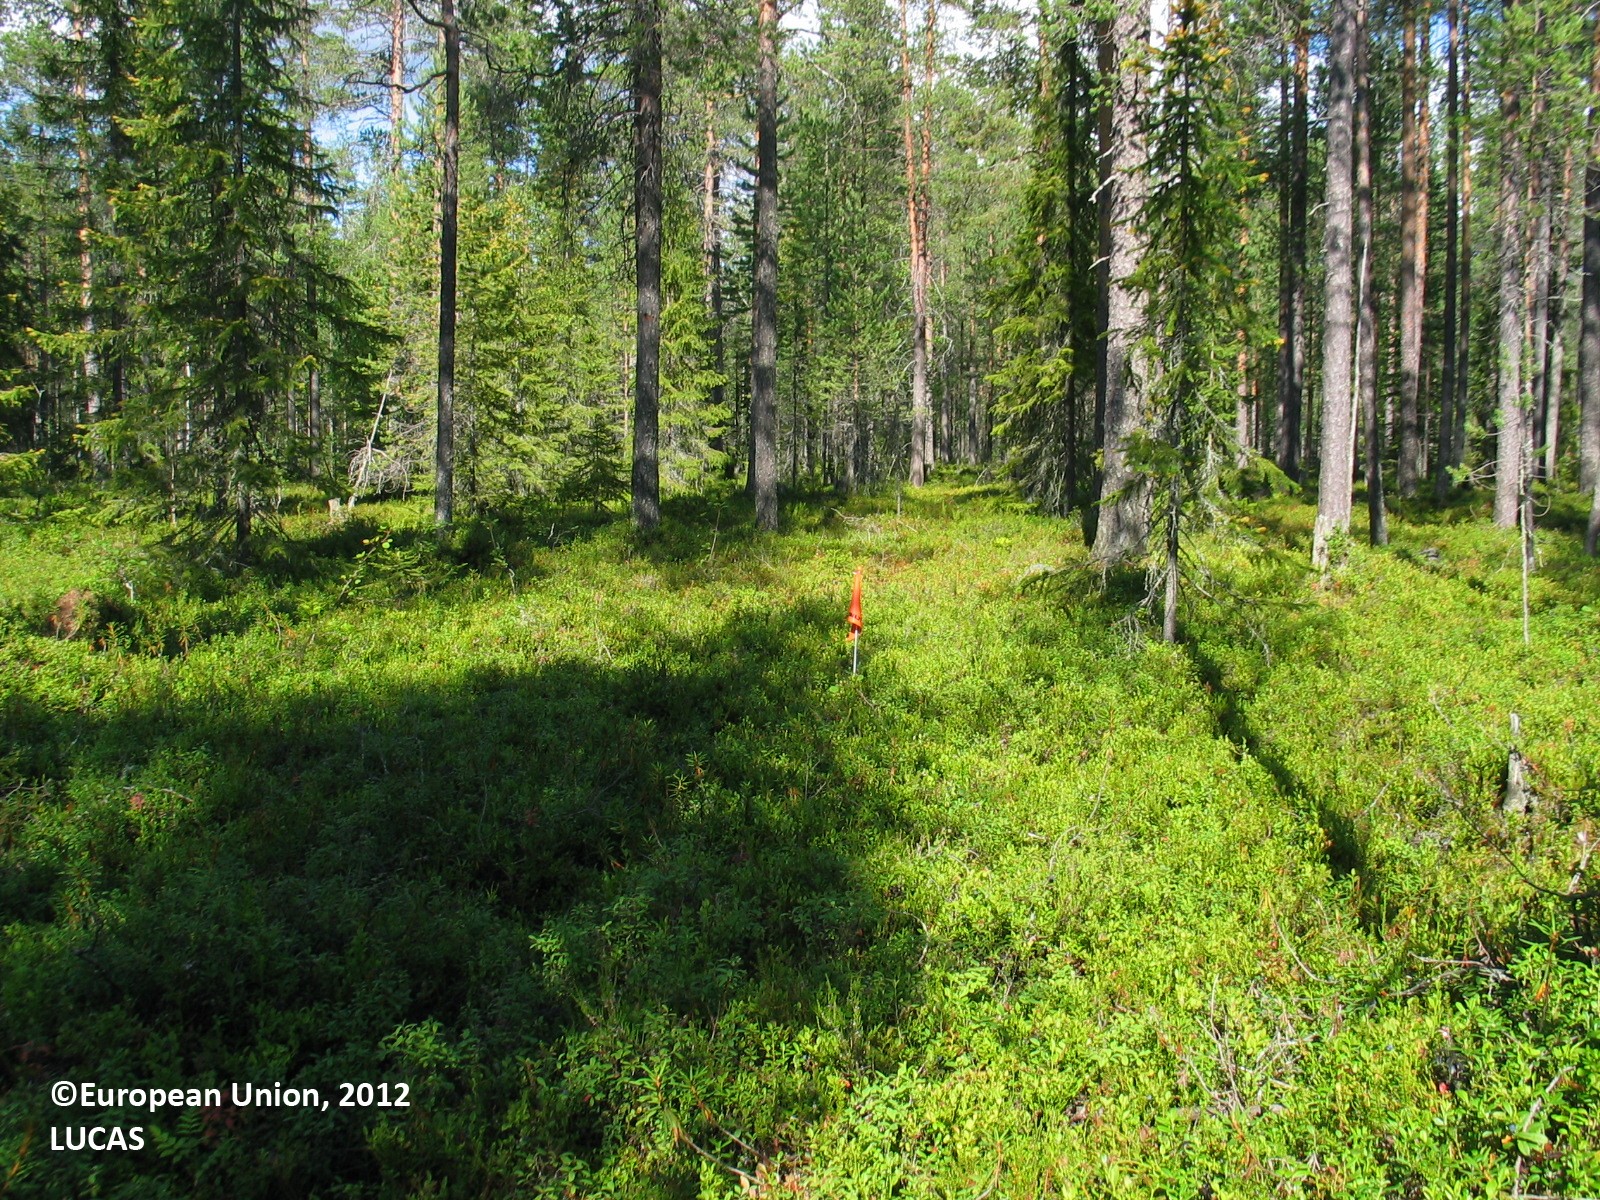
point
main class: Woodland
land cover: Pine dominated coniferous woodland
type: boreal forest
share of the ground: 25 - 50 %
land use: Forestry
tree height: > 5 m
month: August
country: FI
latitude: 65.7032
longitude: 25.8741
